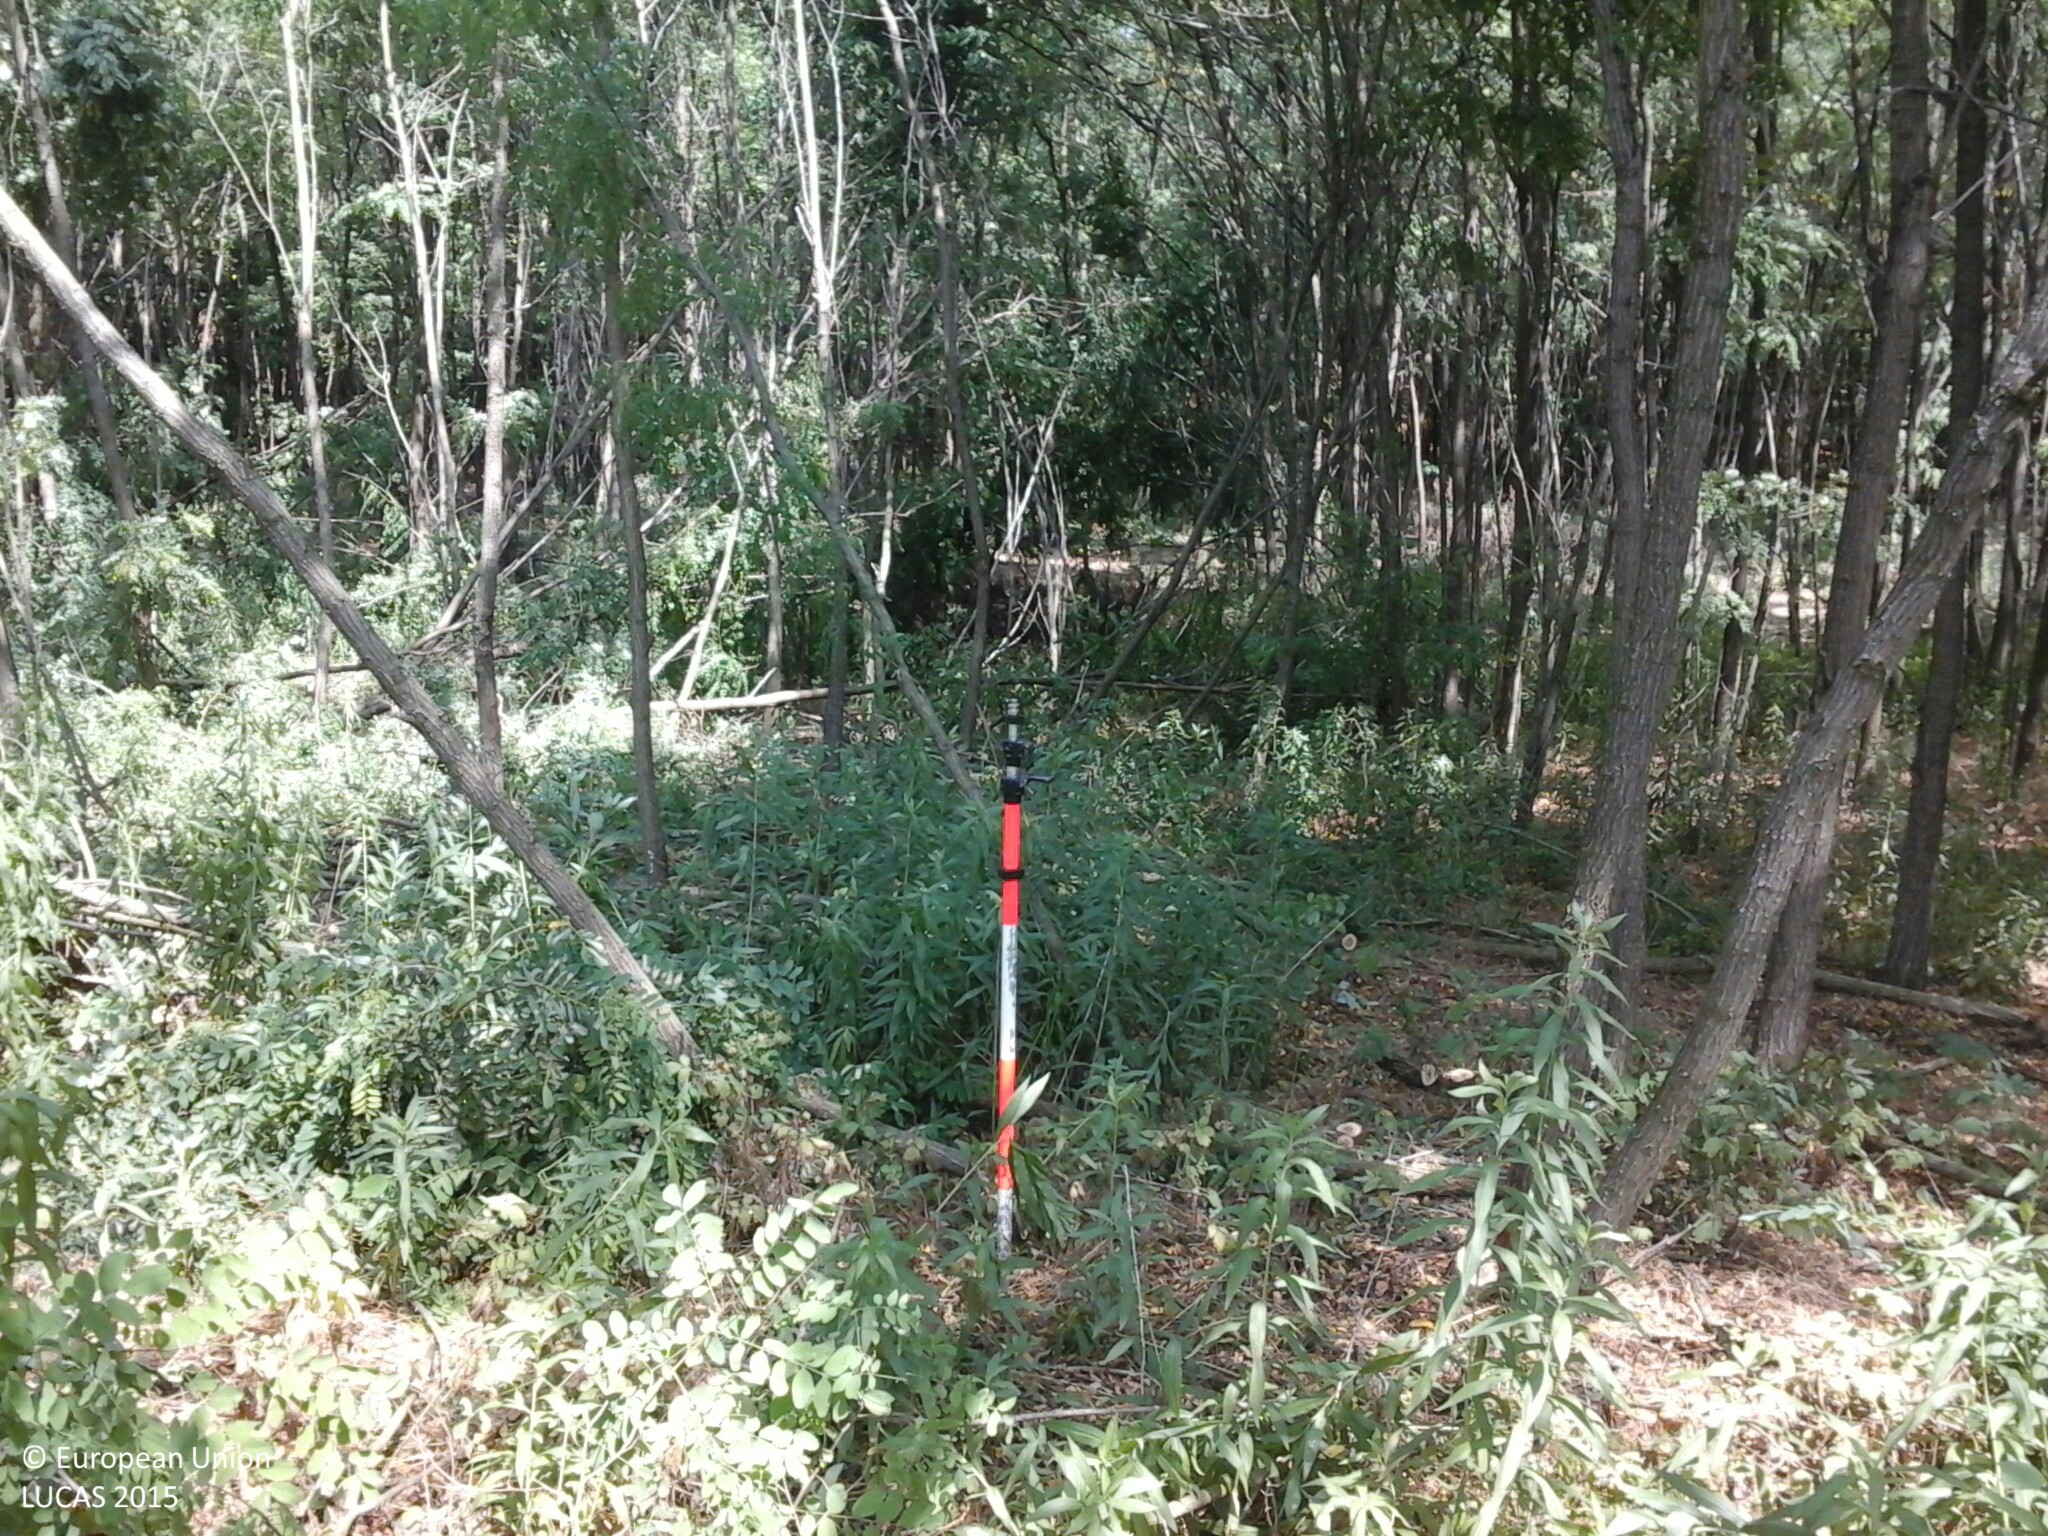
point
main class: Woodland
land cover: Broadleaved woodland
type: mesophytic deciduous forest
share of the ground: 50 - 75 %
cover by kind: broadleaved forest trees 95 %, herbaceous plants 5 %
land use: Forestry
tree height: > 5 m
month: July
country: HU
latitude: 48.3599
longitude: 22.2172
